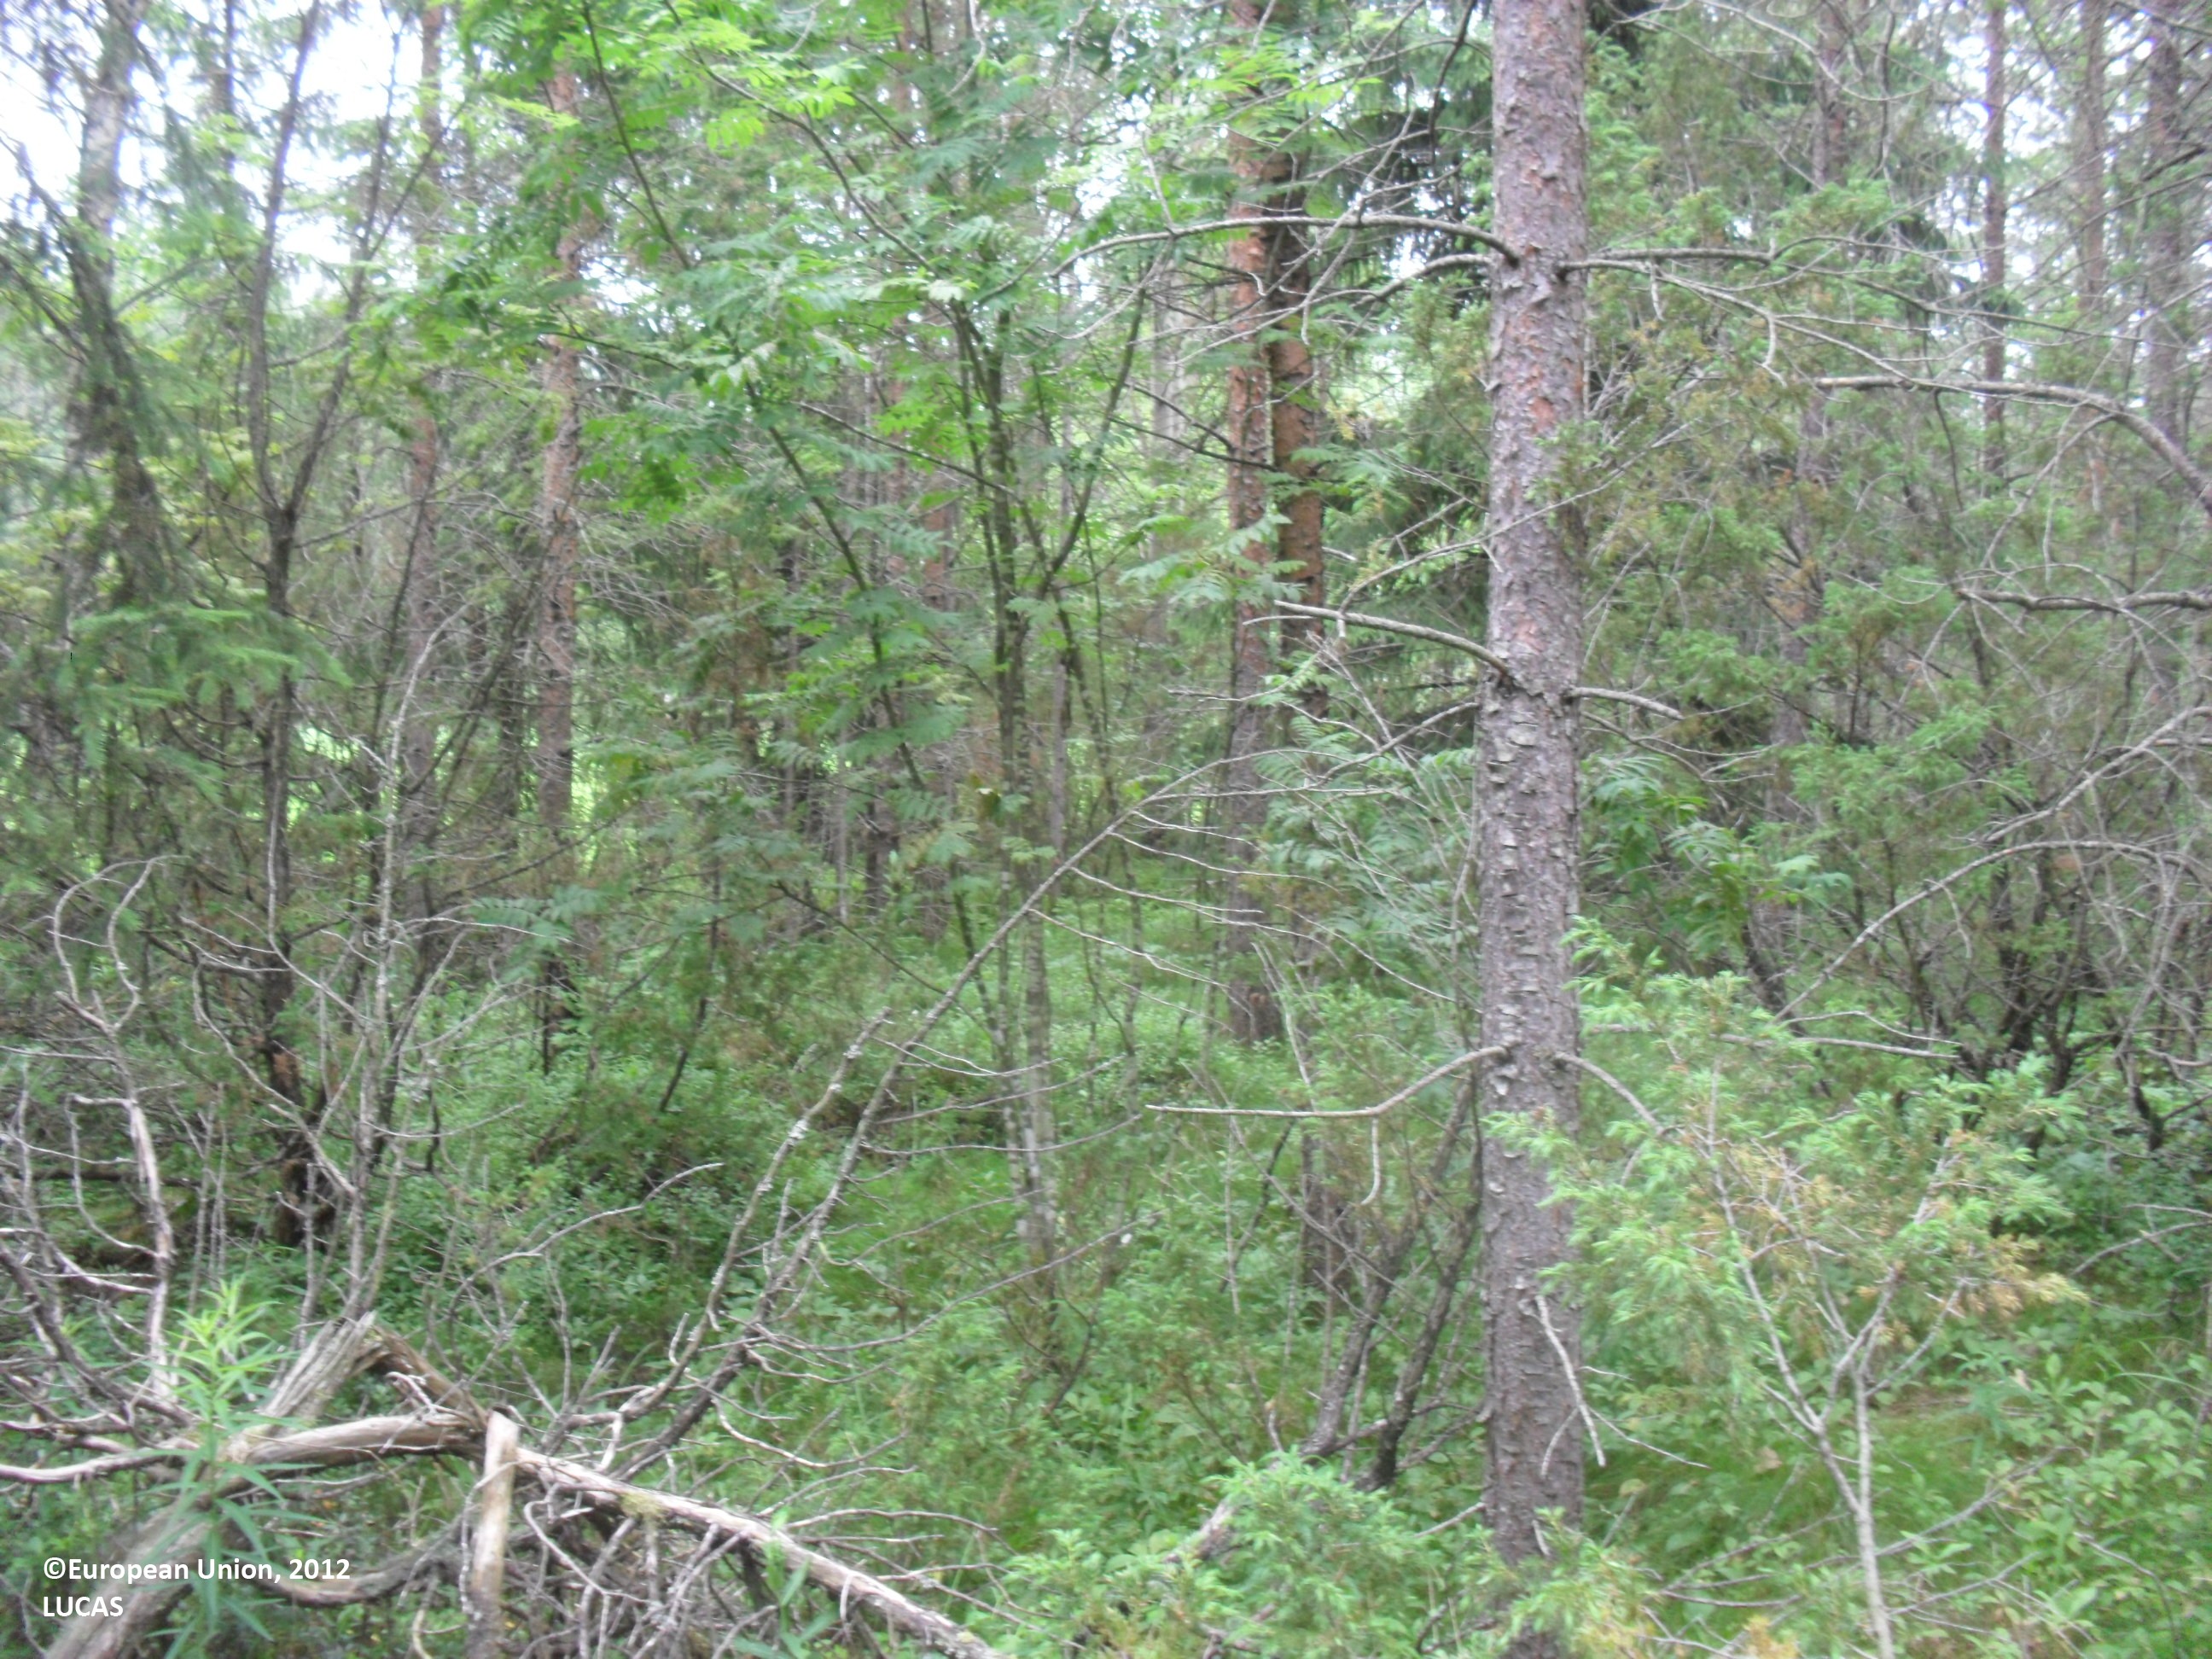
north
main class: Woodland
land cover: Pine dominated mixed woodland
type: boreal forest
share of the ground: 50 - 75 %
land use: Forestry
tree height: > 5 m
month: July
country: FI
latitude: 63.5832
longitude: 23.6627
